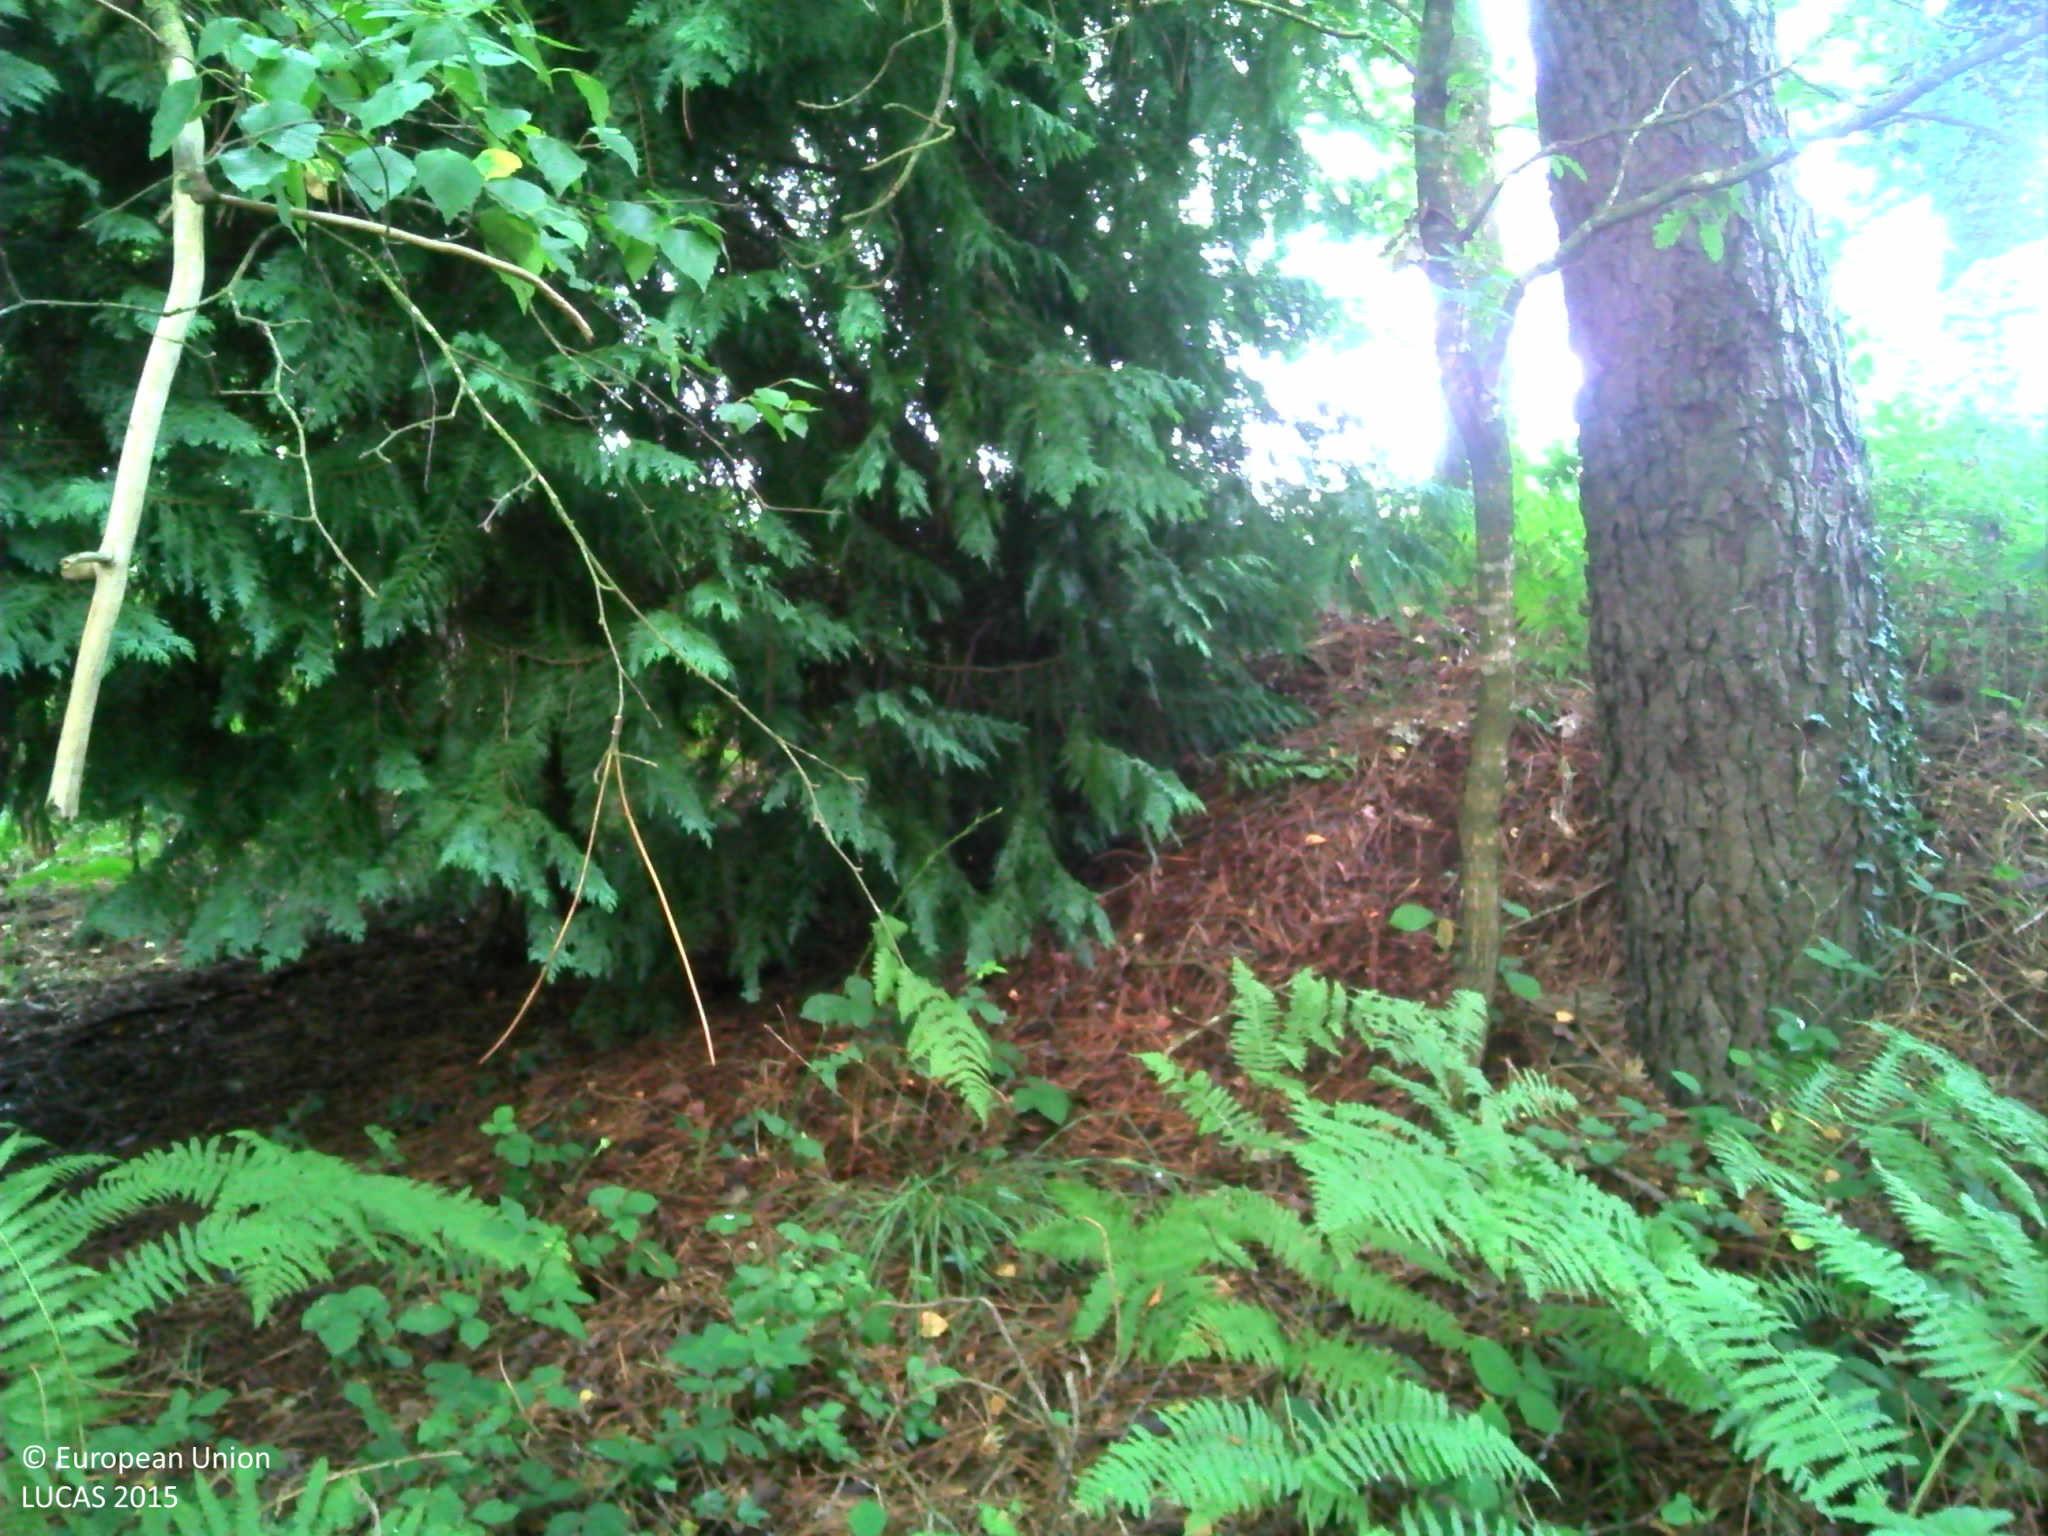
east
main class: Woodland
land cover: Other mixed woodland
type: exotic forest
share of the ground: > 75 %
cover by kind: broadleaved forest trees 40 %, coniferous forest trees 30 %, shrubs 10 %, herbaceous plants 10 %, consolidated bare surface 10 %
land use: Forestry
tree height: > 5 m
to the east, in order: Other mixed woodland; Spontaneously vegetated surfaces; Lucerne; Electric lines; Lucerne; Tracks; Managed hedges; Maize
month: July
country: FR
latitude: 47.8405
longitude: -2.9330
